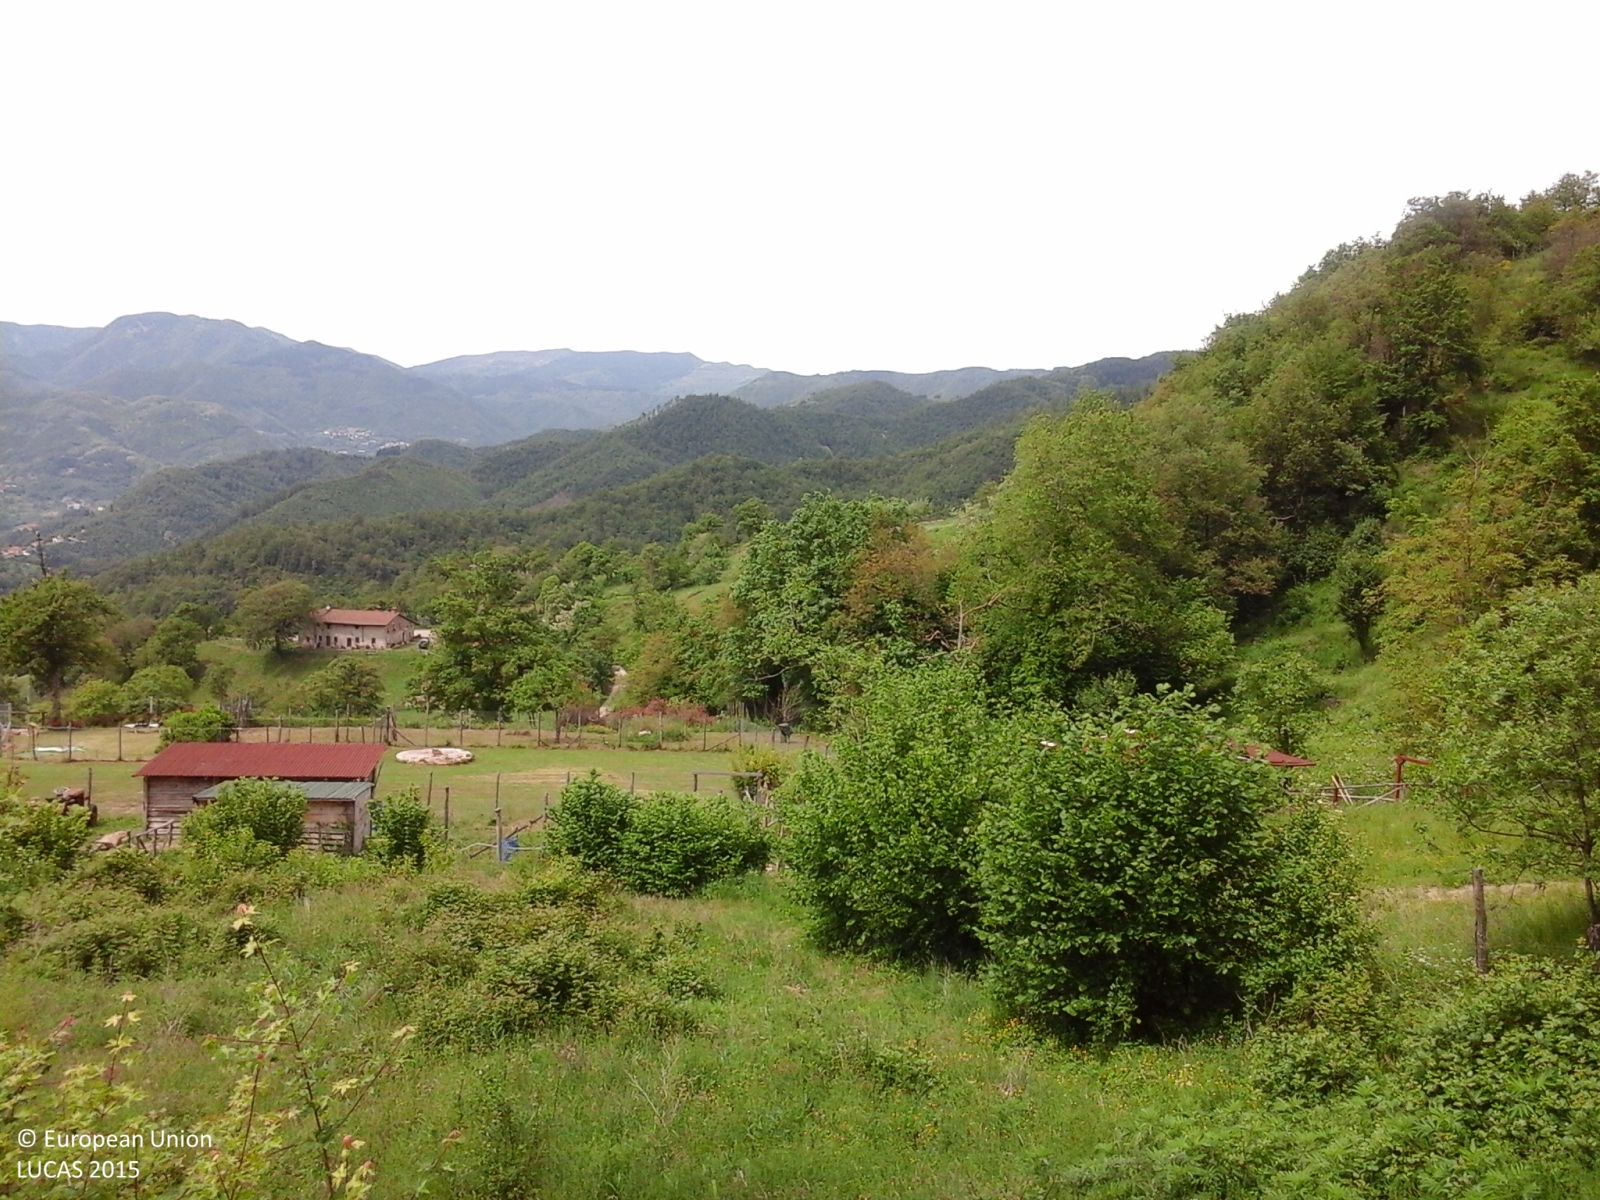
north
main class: Grassland
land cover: Grassland with sparse tree/shrub cover
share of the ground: > 75 %
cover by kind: herbaceous plants 85 %, shrubs 10 %, broadleaved forest trees 5 %
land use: Semi-natural and natural areas not in use
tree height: < 5 m
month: May
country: IT
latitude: 44.0191
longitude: 11.1822
